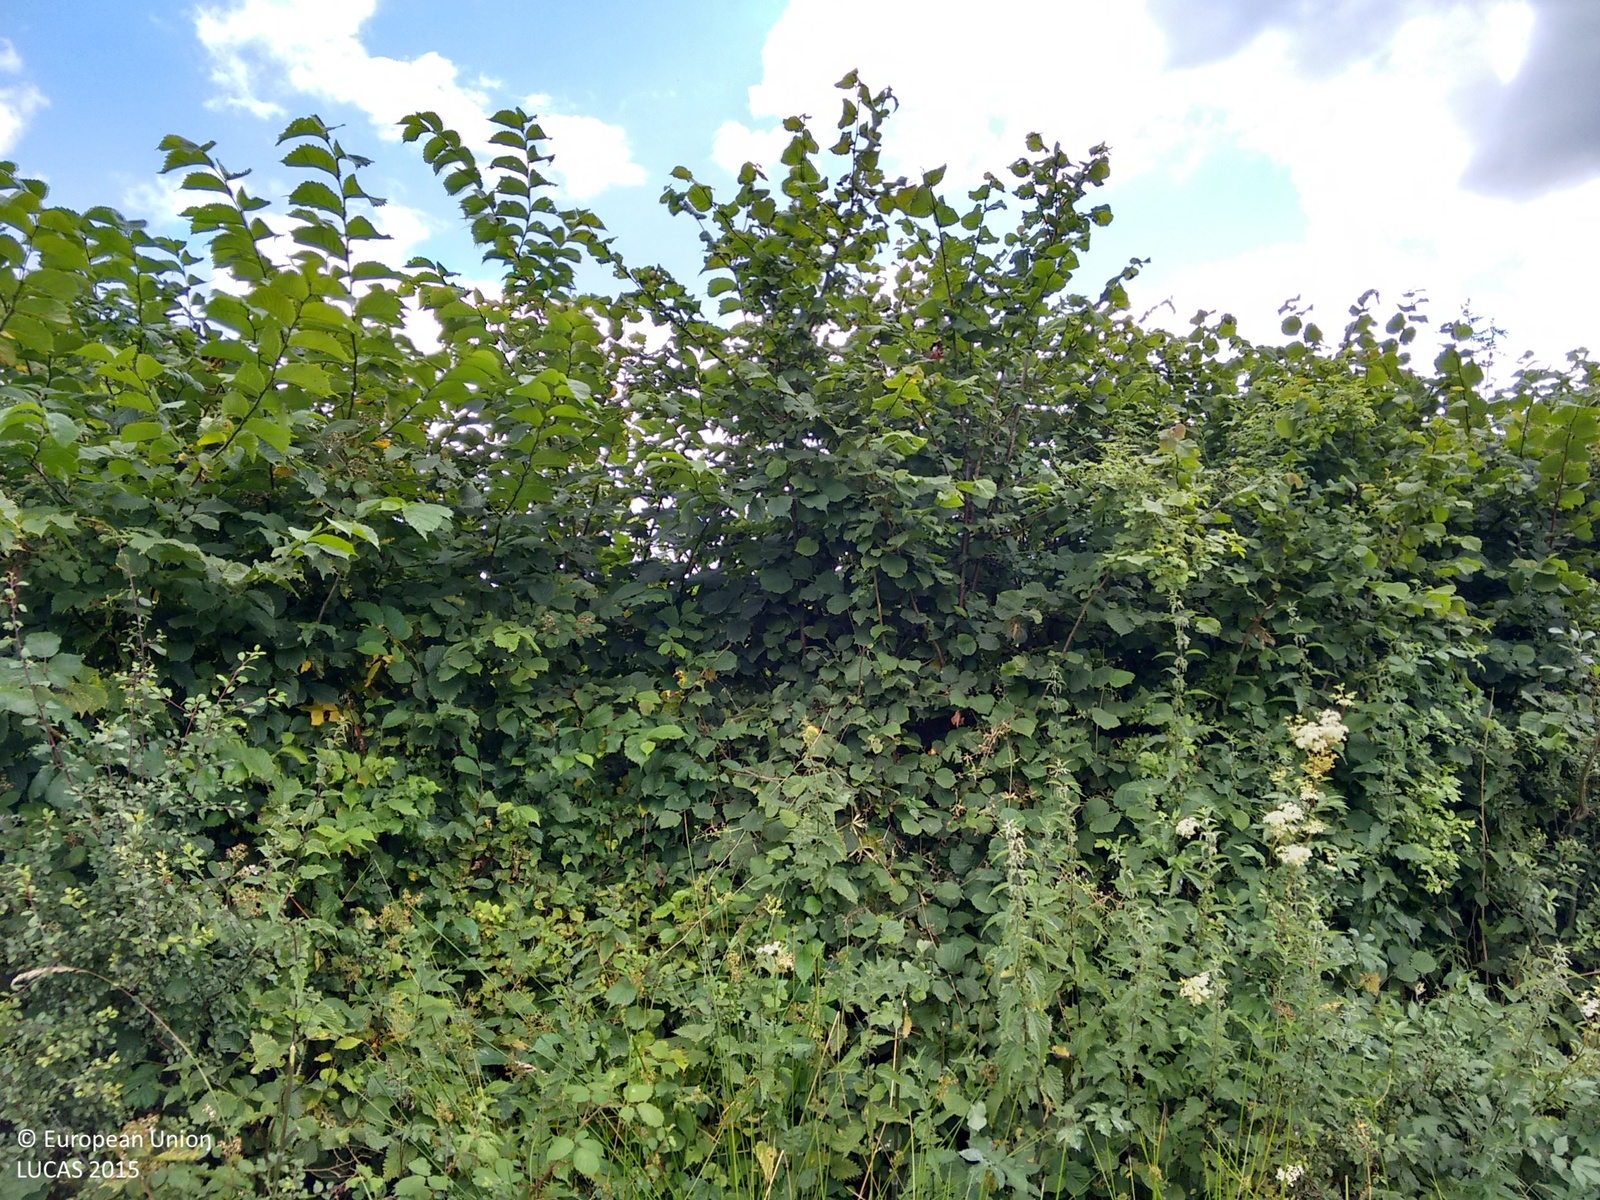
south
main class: Grassland
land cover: Grassland without tree/shrub cover
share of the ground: > 75 %
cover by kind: herbaceous plants 100 %
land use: Agriculture (excluding fallow land and kitchen gardens)
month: August
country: GB
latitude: 51.8789
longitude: -4.0855
